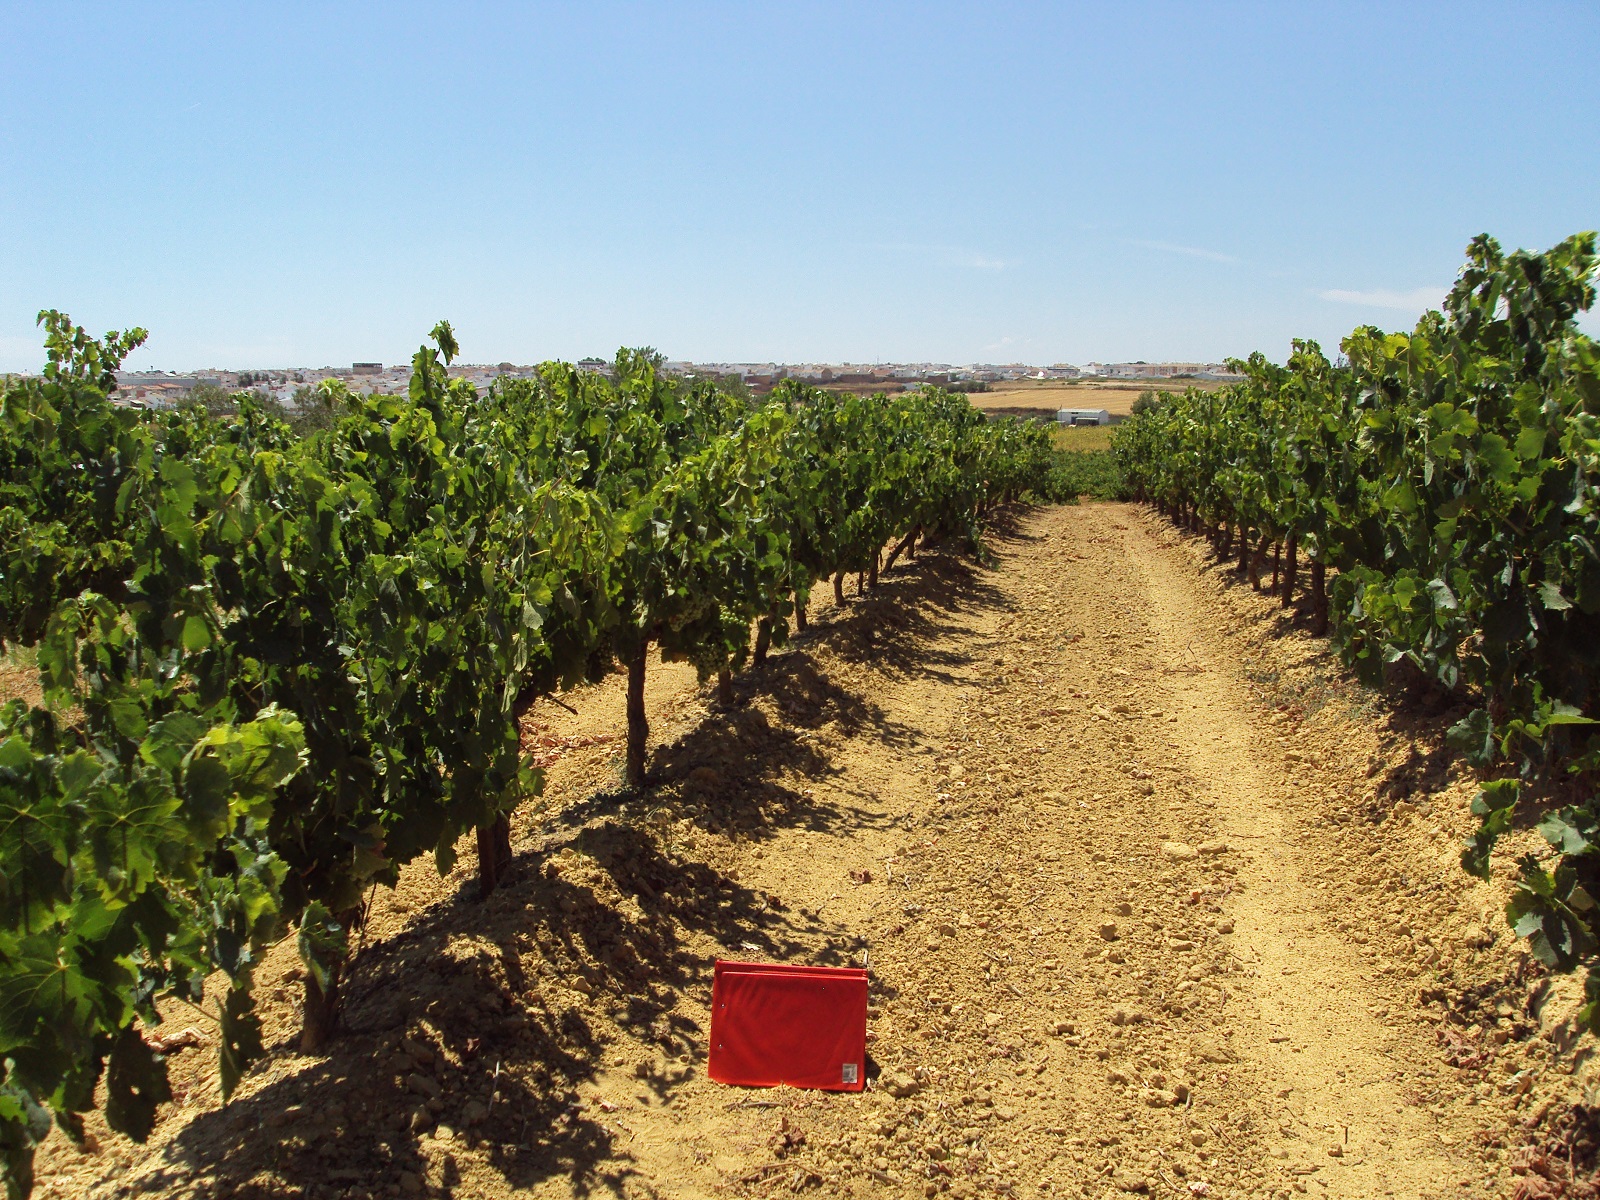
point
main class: Cropland
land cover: Vineyards
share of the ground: > 75 %
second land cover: Other bare soil
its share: > 75 %
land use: Agriculture (excluding fallow land and kitchen gardens)
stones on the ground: < 10 %
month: June
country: ES
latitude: 37.3433
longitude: -6.5237
